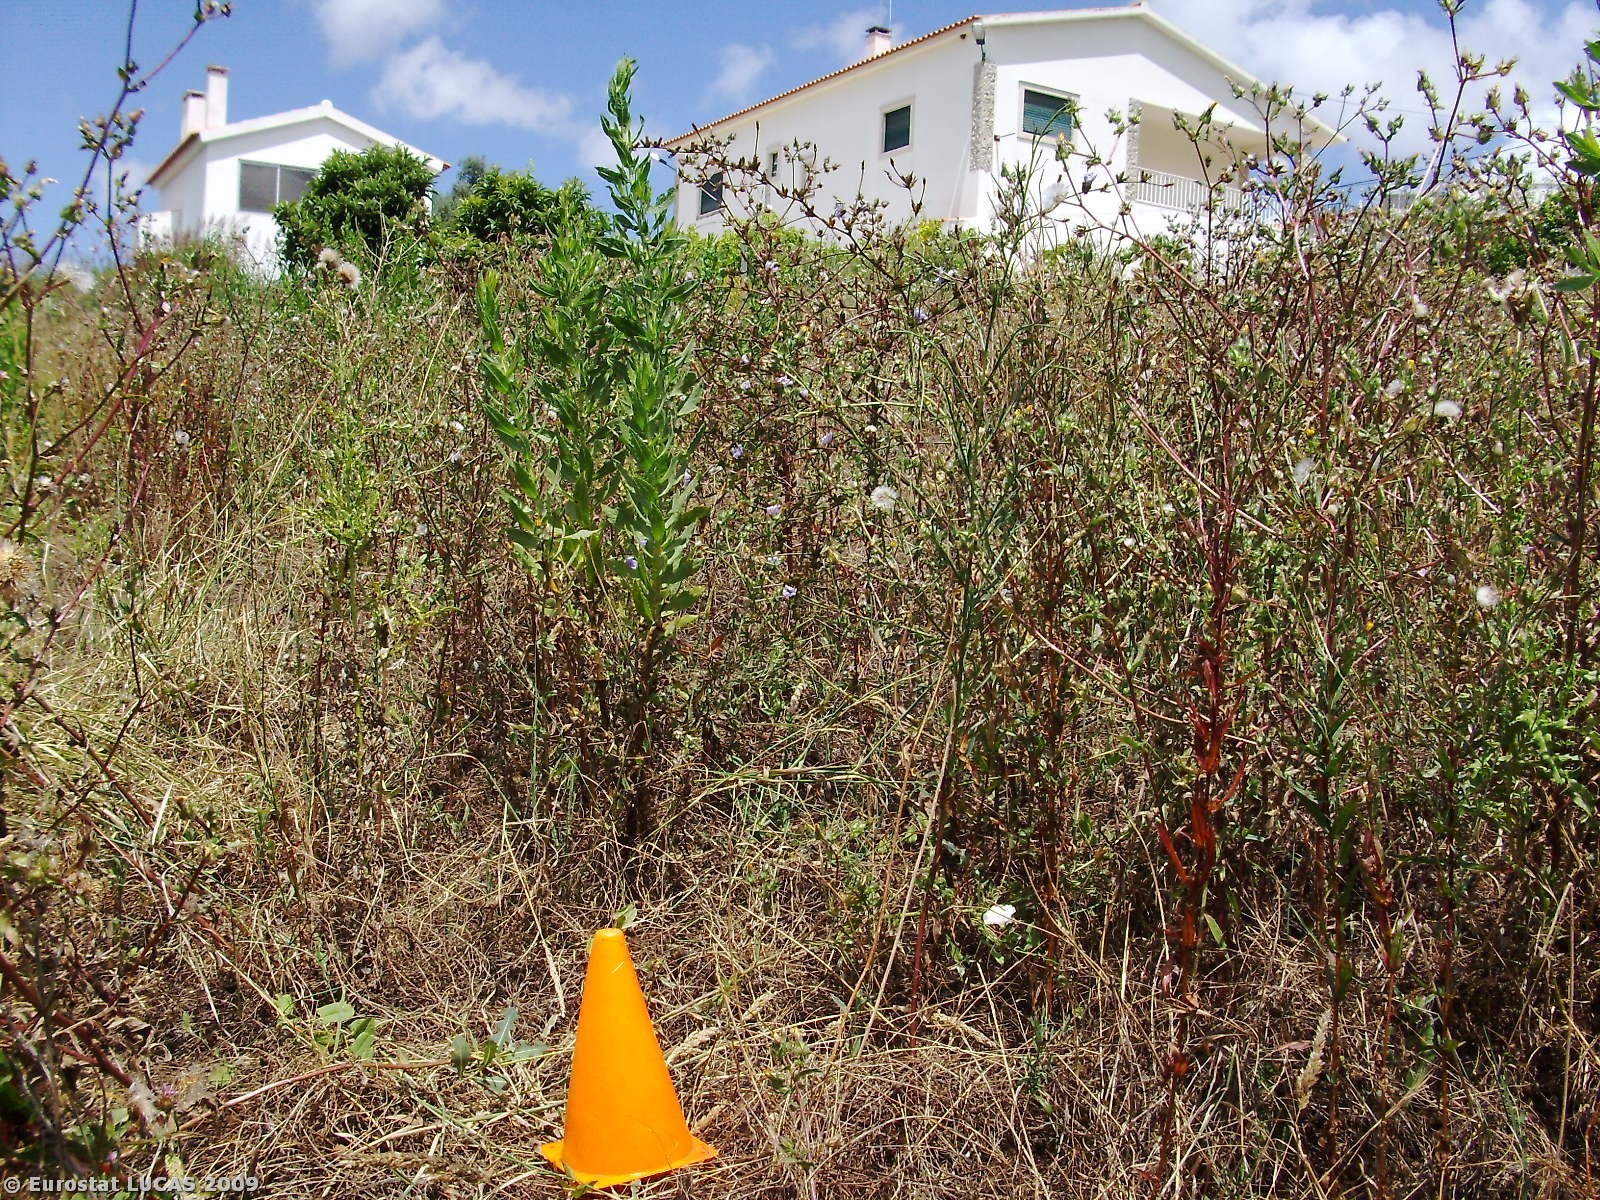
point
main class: Grassland
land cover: Spontaneously vegetated surfaces
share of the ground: > 75 %
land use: Fallow land
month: July
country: PT
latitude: 39.4702
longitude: -9.0702
